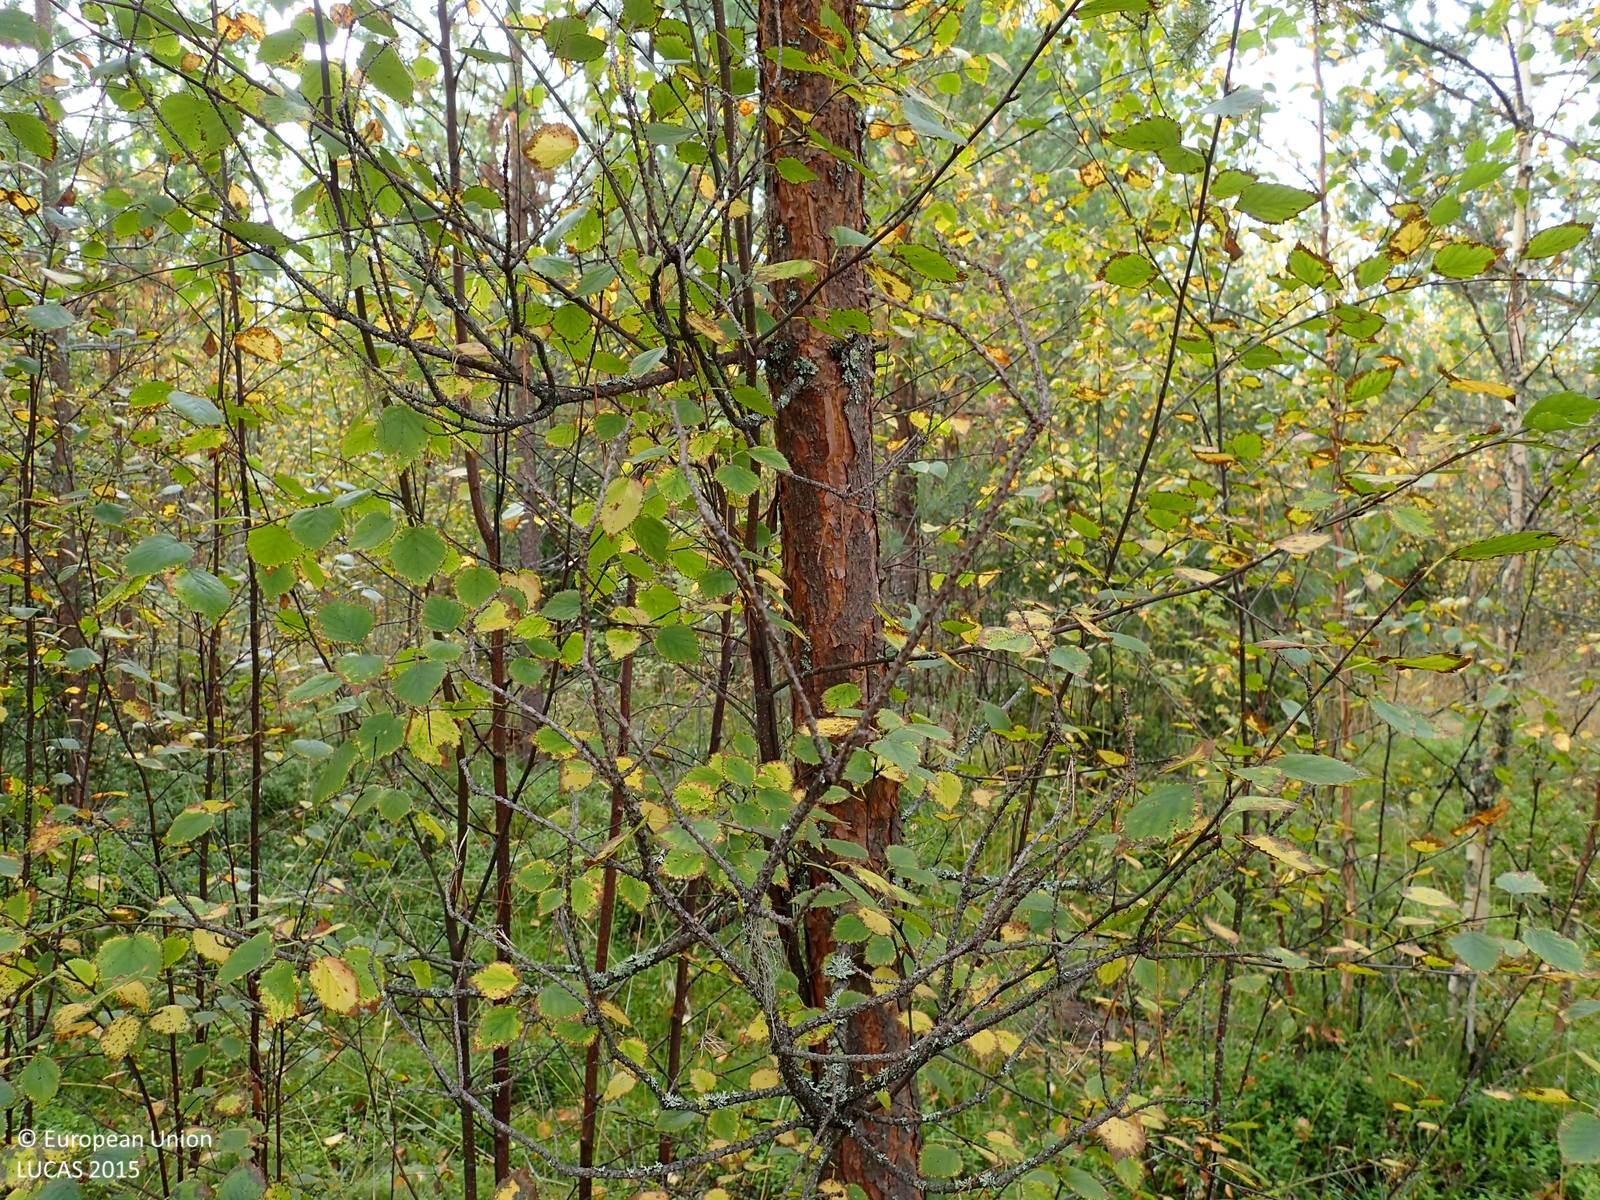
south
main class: Woodland
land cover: Pine dominated mixed woodland
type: boreal forest
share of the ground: > 75 %
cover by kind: coniferous forest trees 60 %, broadleaved forest trees 20 %, shrubs 10 %, herbaceous plants 5 %, lichens and mosses 5 %
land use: Forestry
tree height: < 5 m
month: September
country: FI
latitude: 63.1337
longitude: 26.0050
